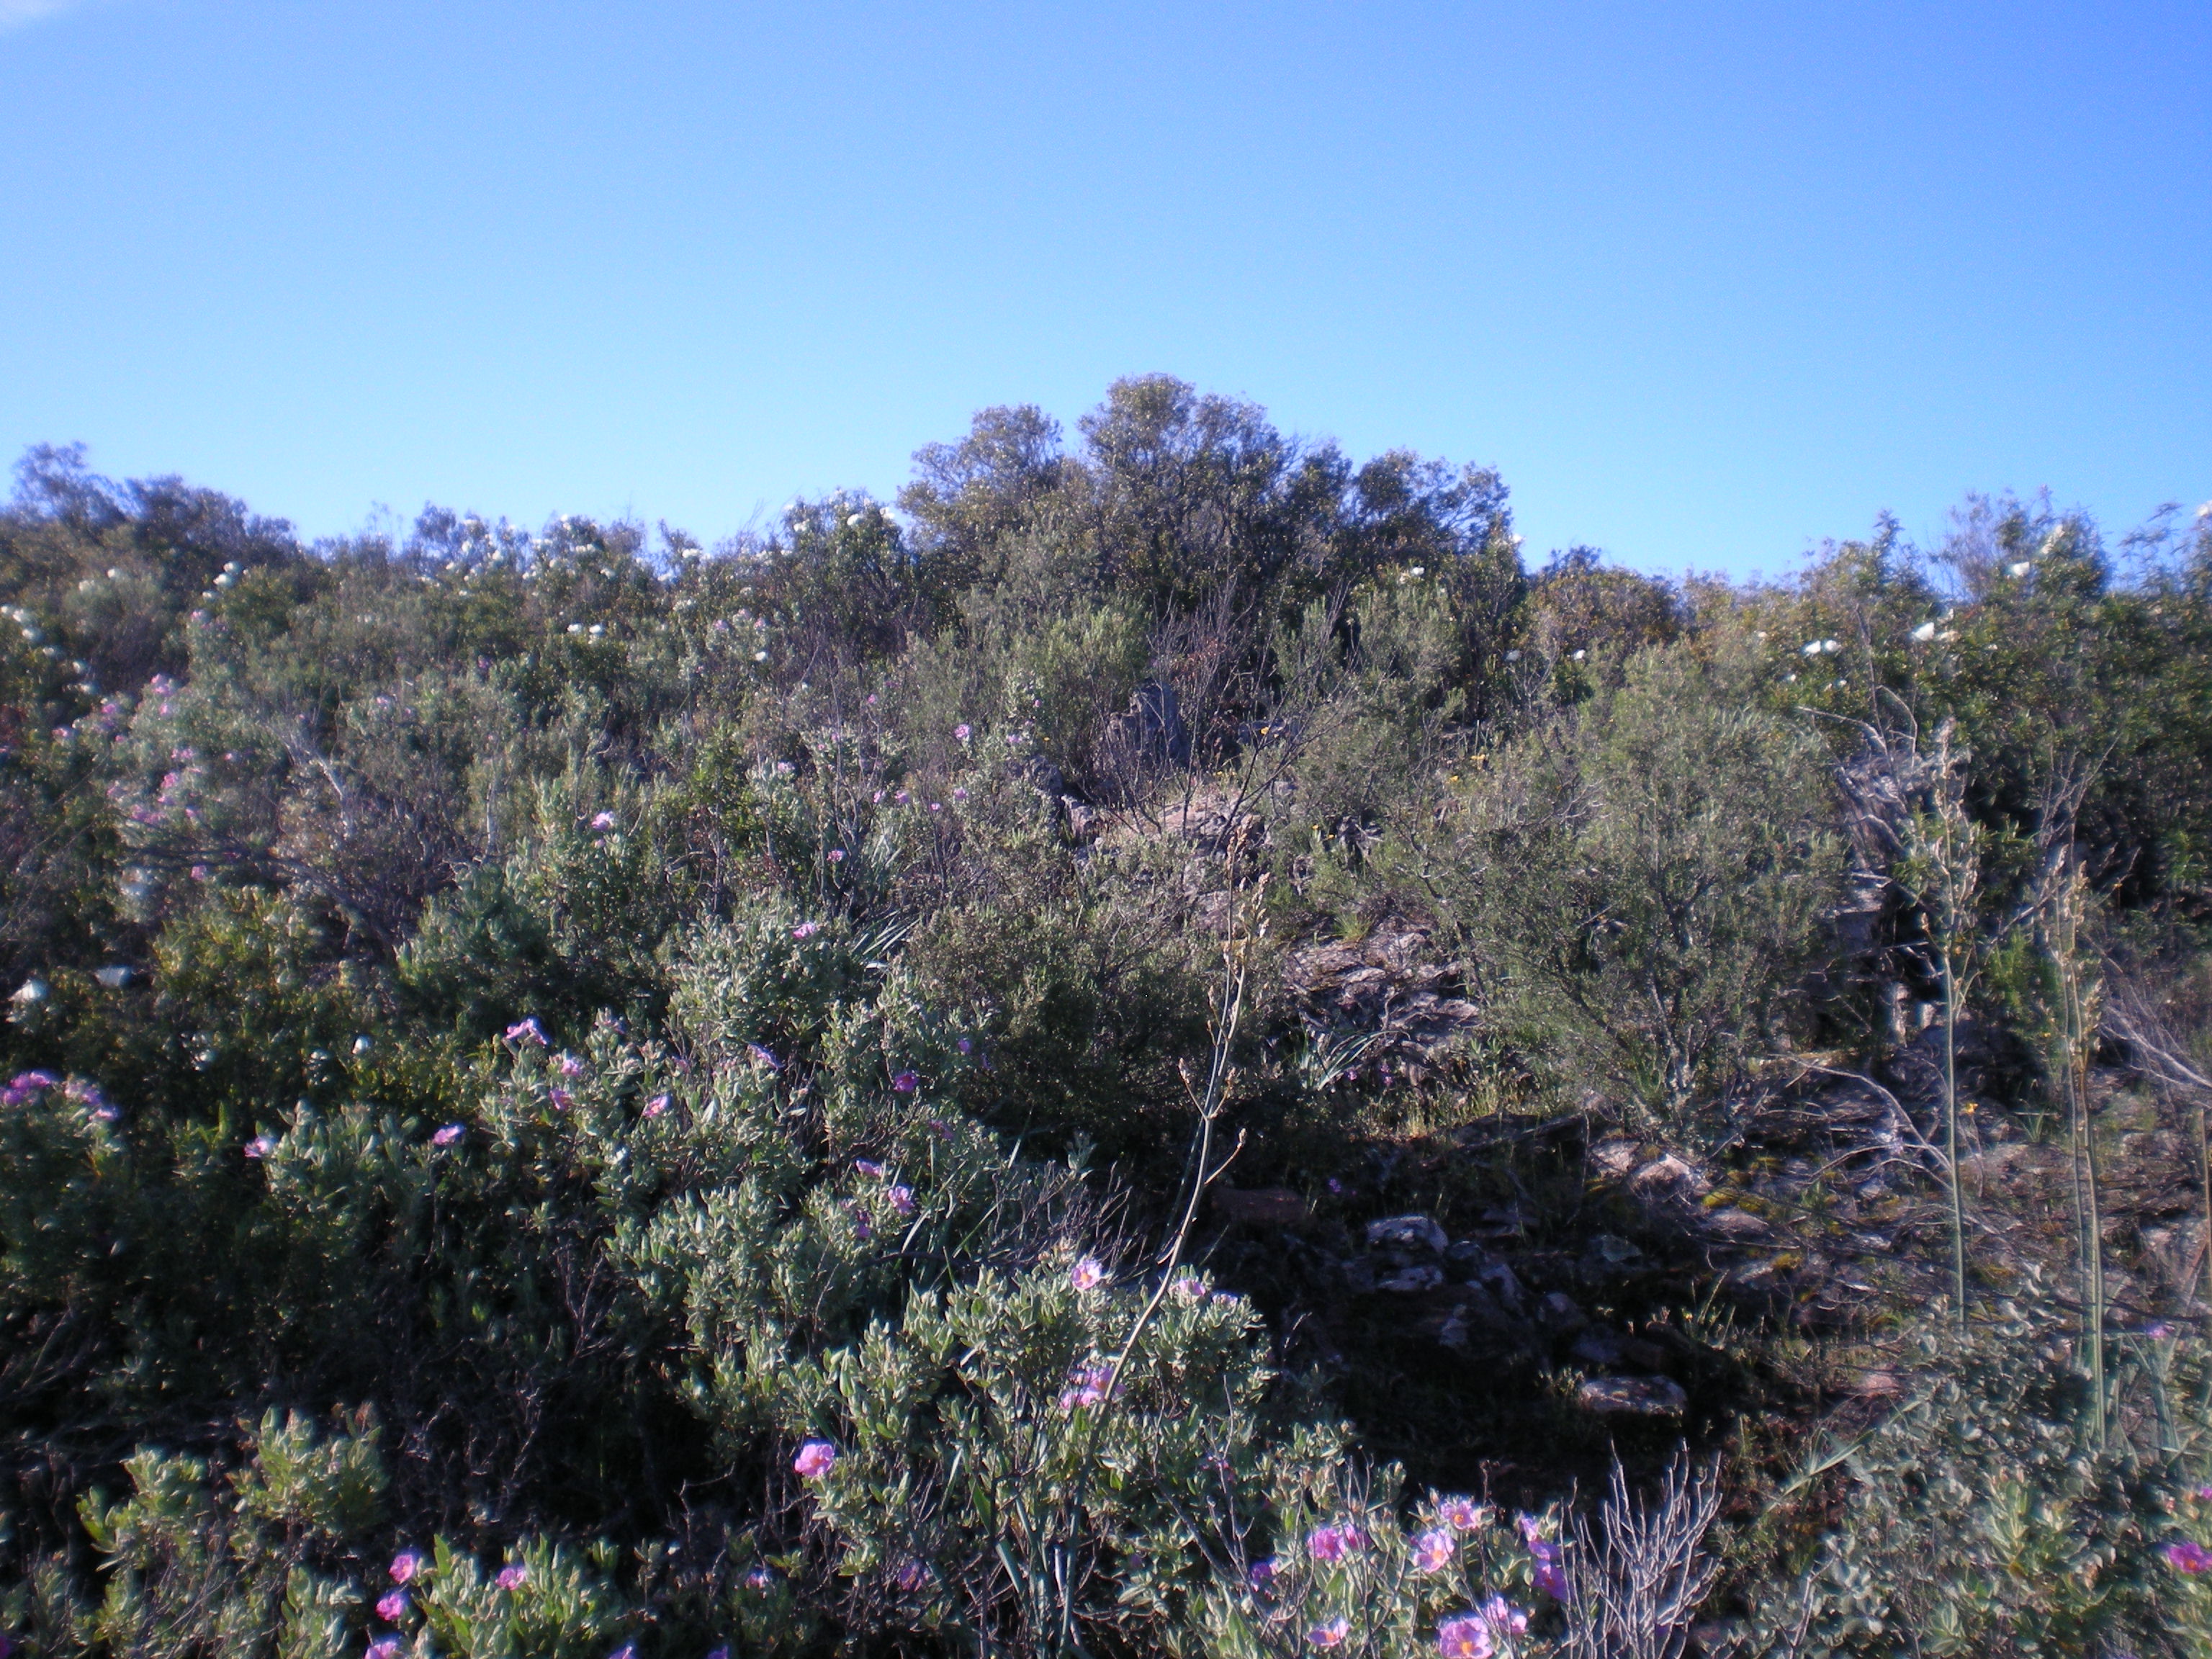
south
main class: Shrubland
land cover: Shrubland with sparse tree cover
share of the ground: > 75 %
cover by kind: shrubs 80 %, consolidated bare surface 15 %, broadleaved forest trees 5 %
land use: Other primary production
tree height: < 5 m
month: April
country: ES
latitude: 38.5651
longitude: -3.3321
